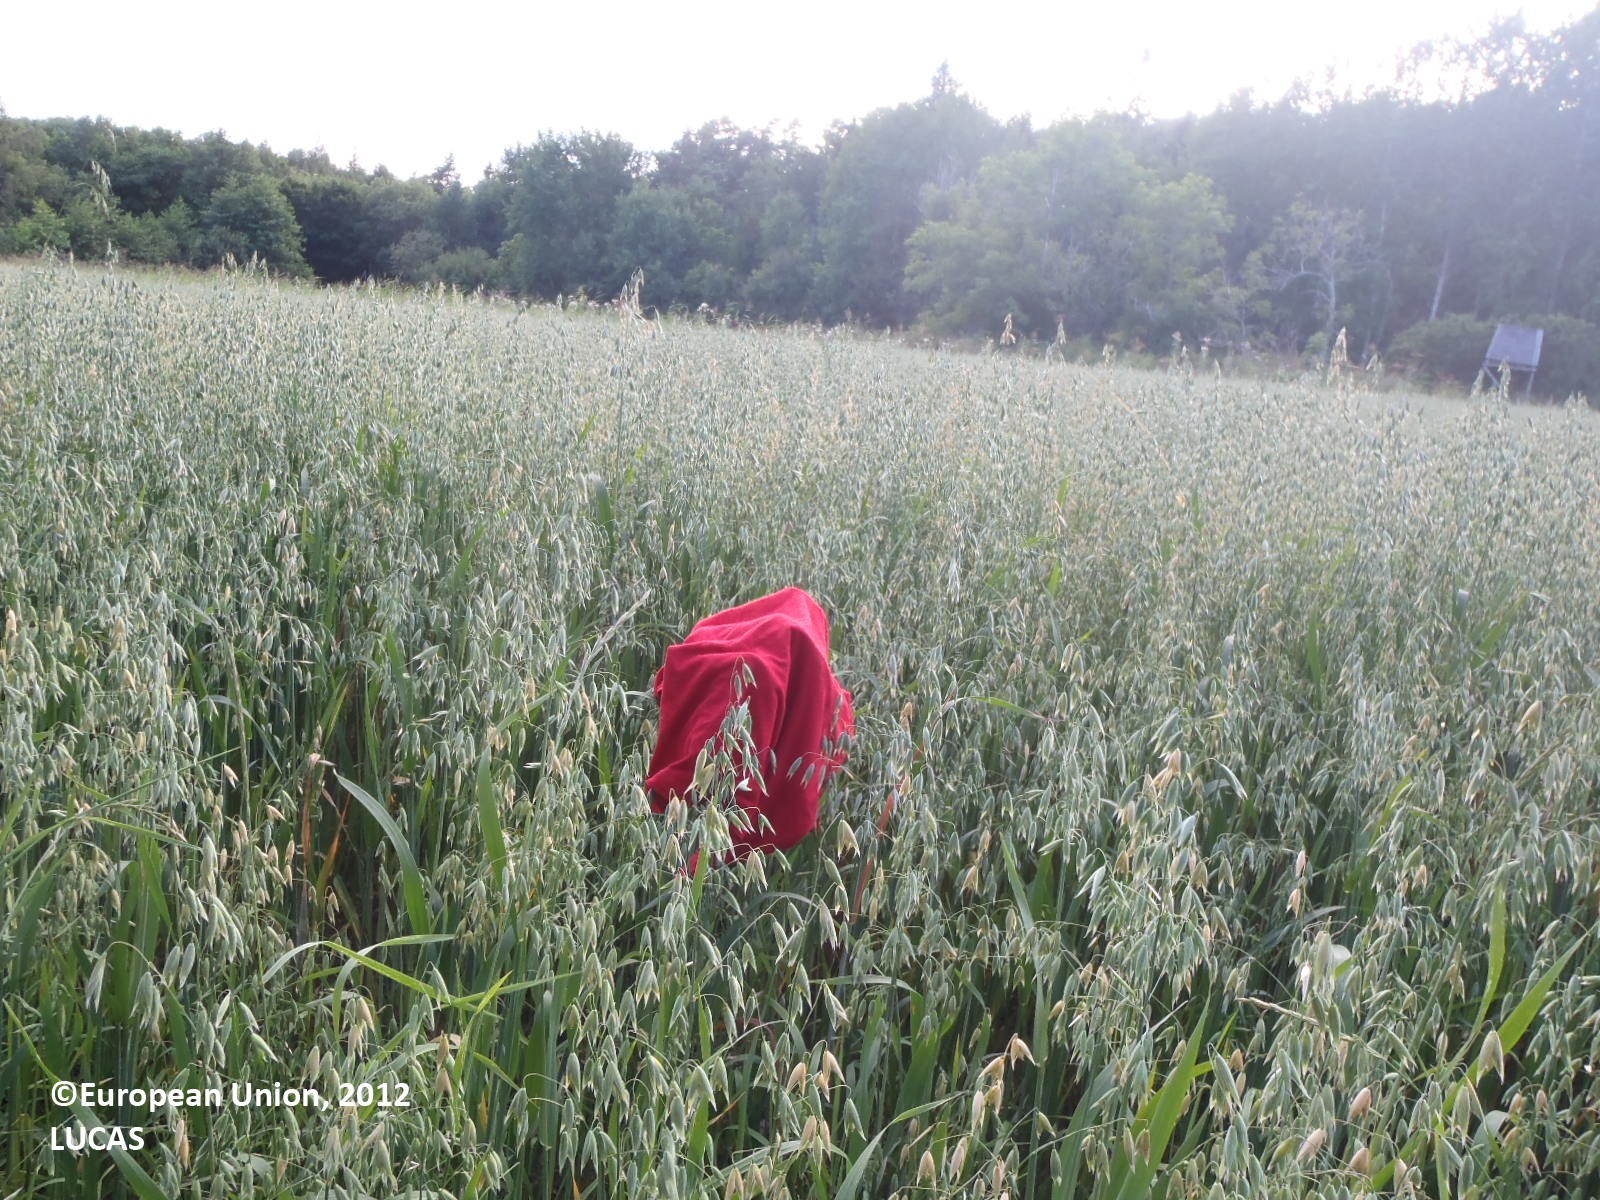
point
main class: Cropland
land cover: Oats
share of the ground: > 75 %
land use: Agriculture (excluding fallow land and kitchen gardens)
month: August
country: FI
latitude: 60.0181
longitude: 20.5800
